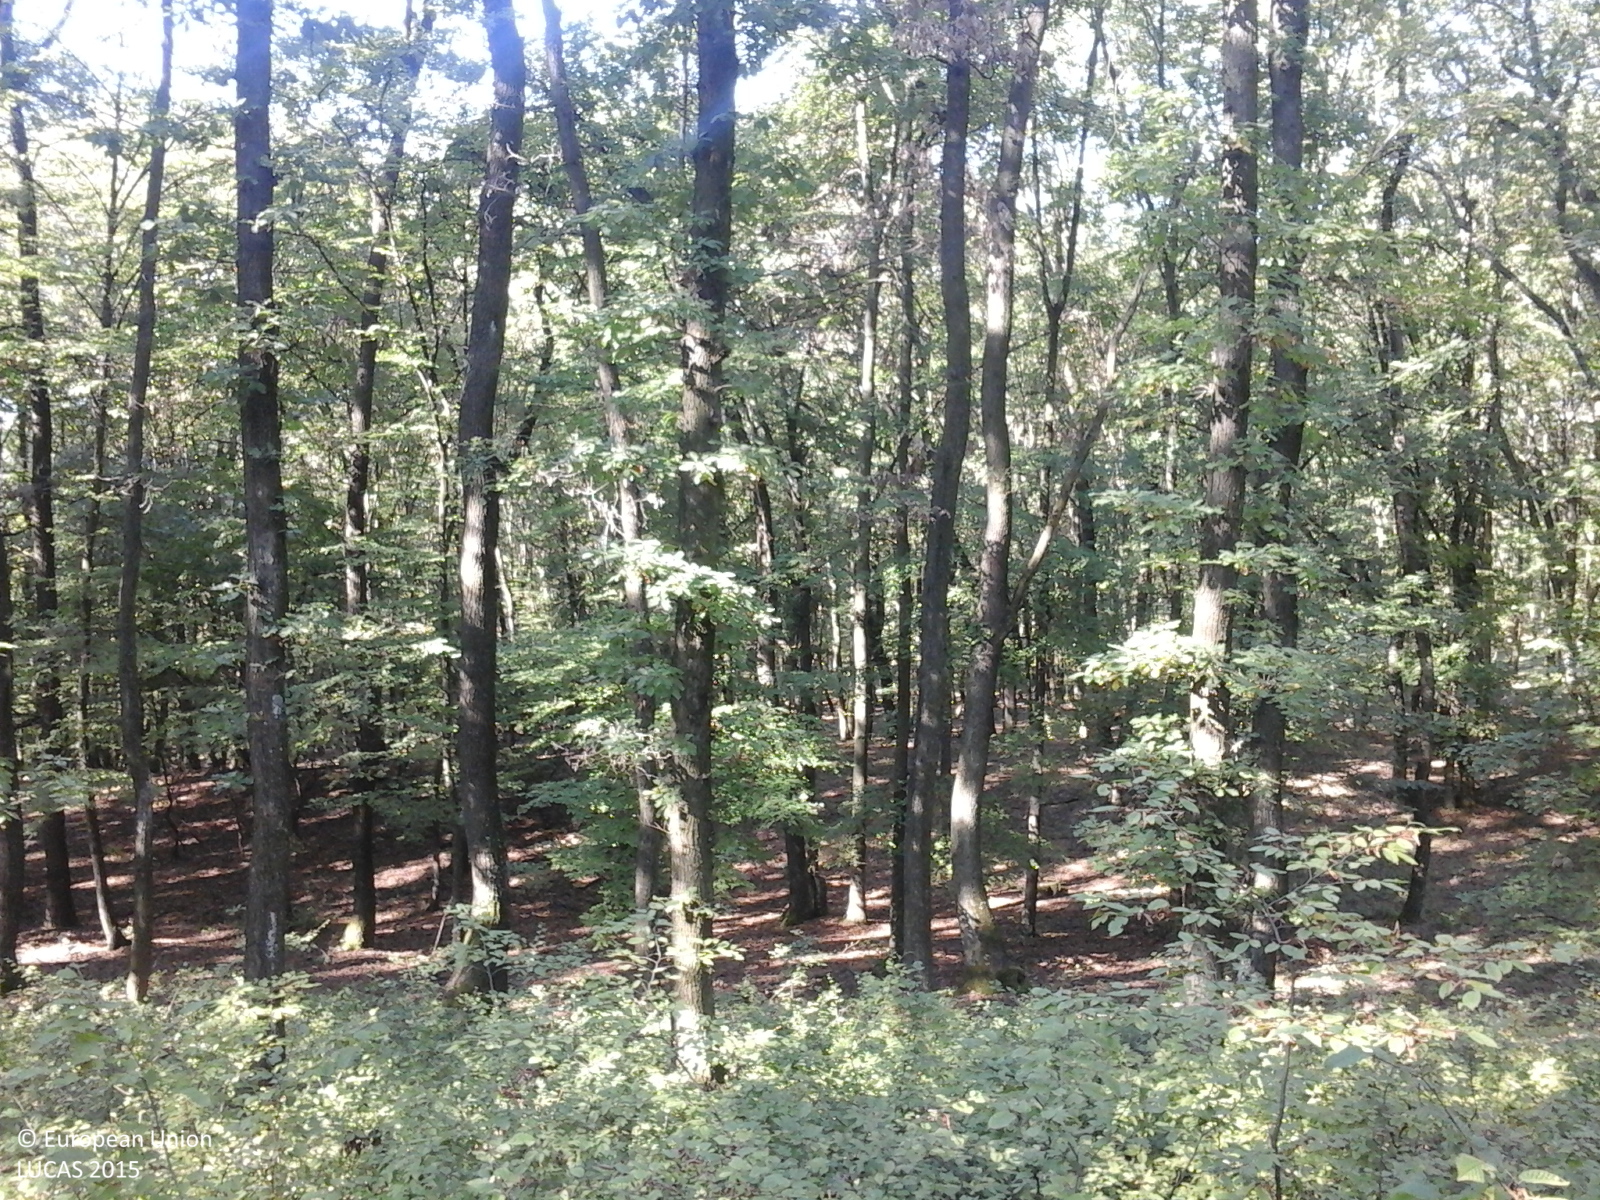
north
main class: Woodland
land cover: Broadleaved woodland
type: acidophilous oak and oak-birch forest
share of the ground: > 75 %
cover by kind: broadleaved forest trees 90 %, herbaceous plants 10 %
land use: Forestry
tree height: > 5 m
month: October
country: RO
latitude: 46.3069
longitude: 23.8227
